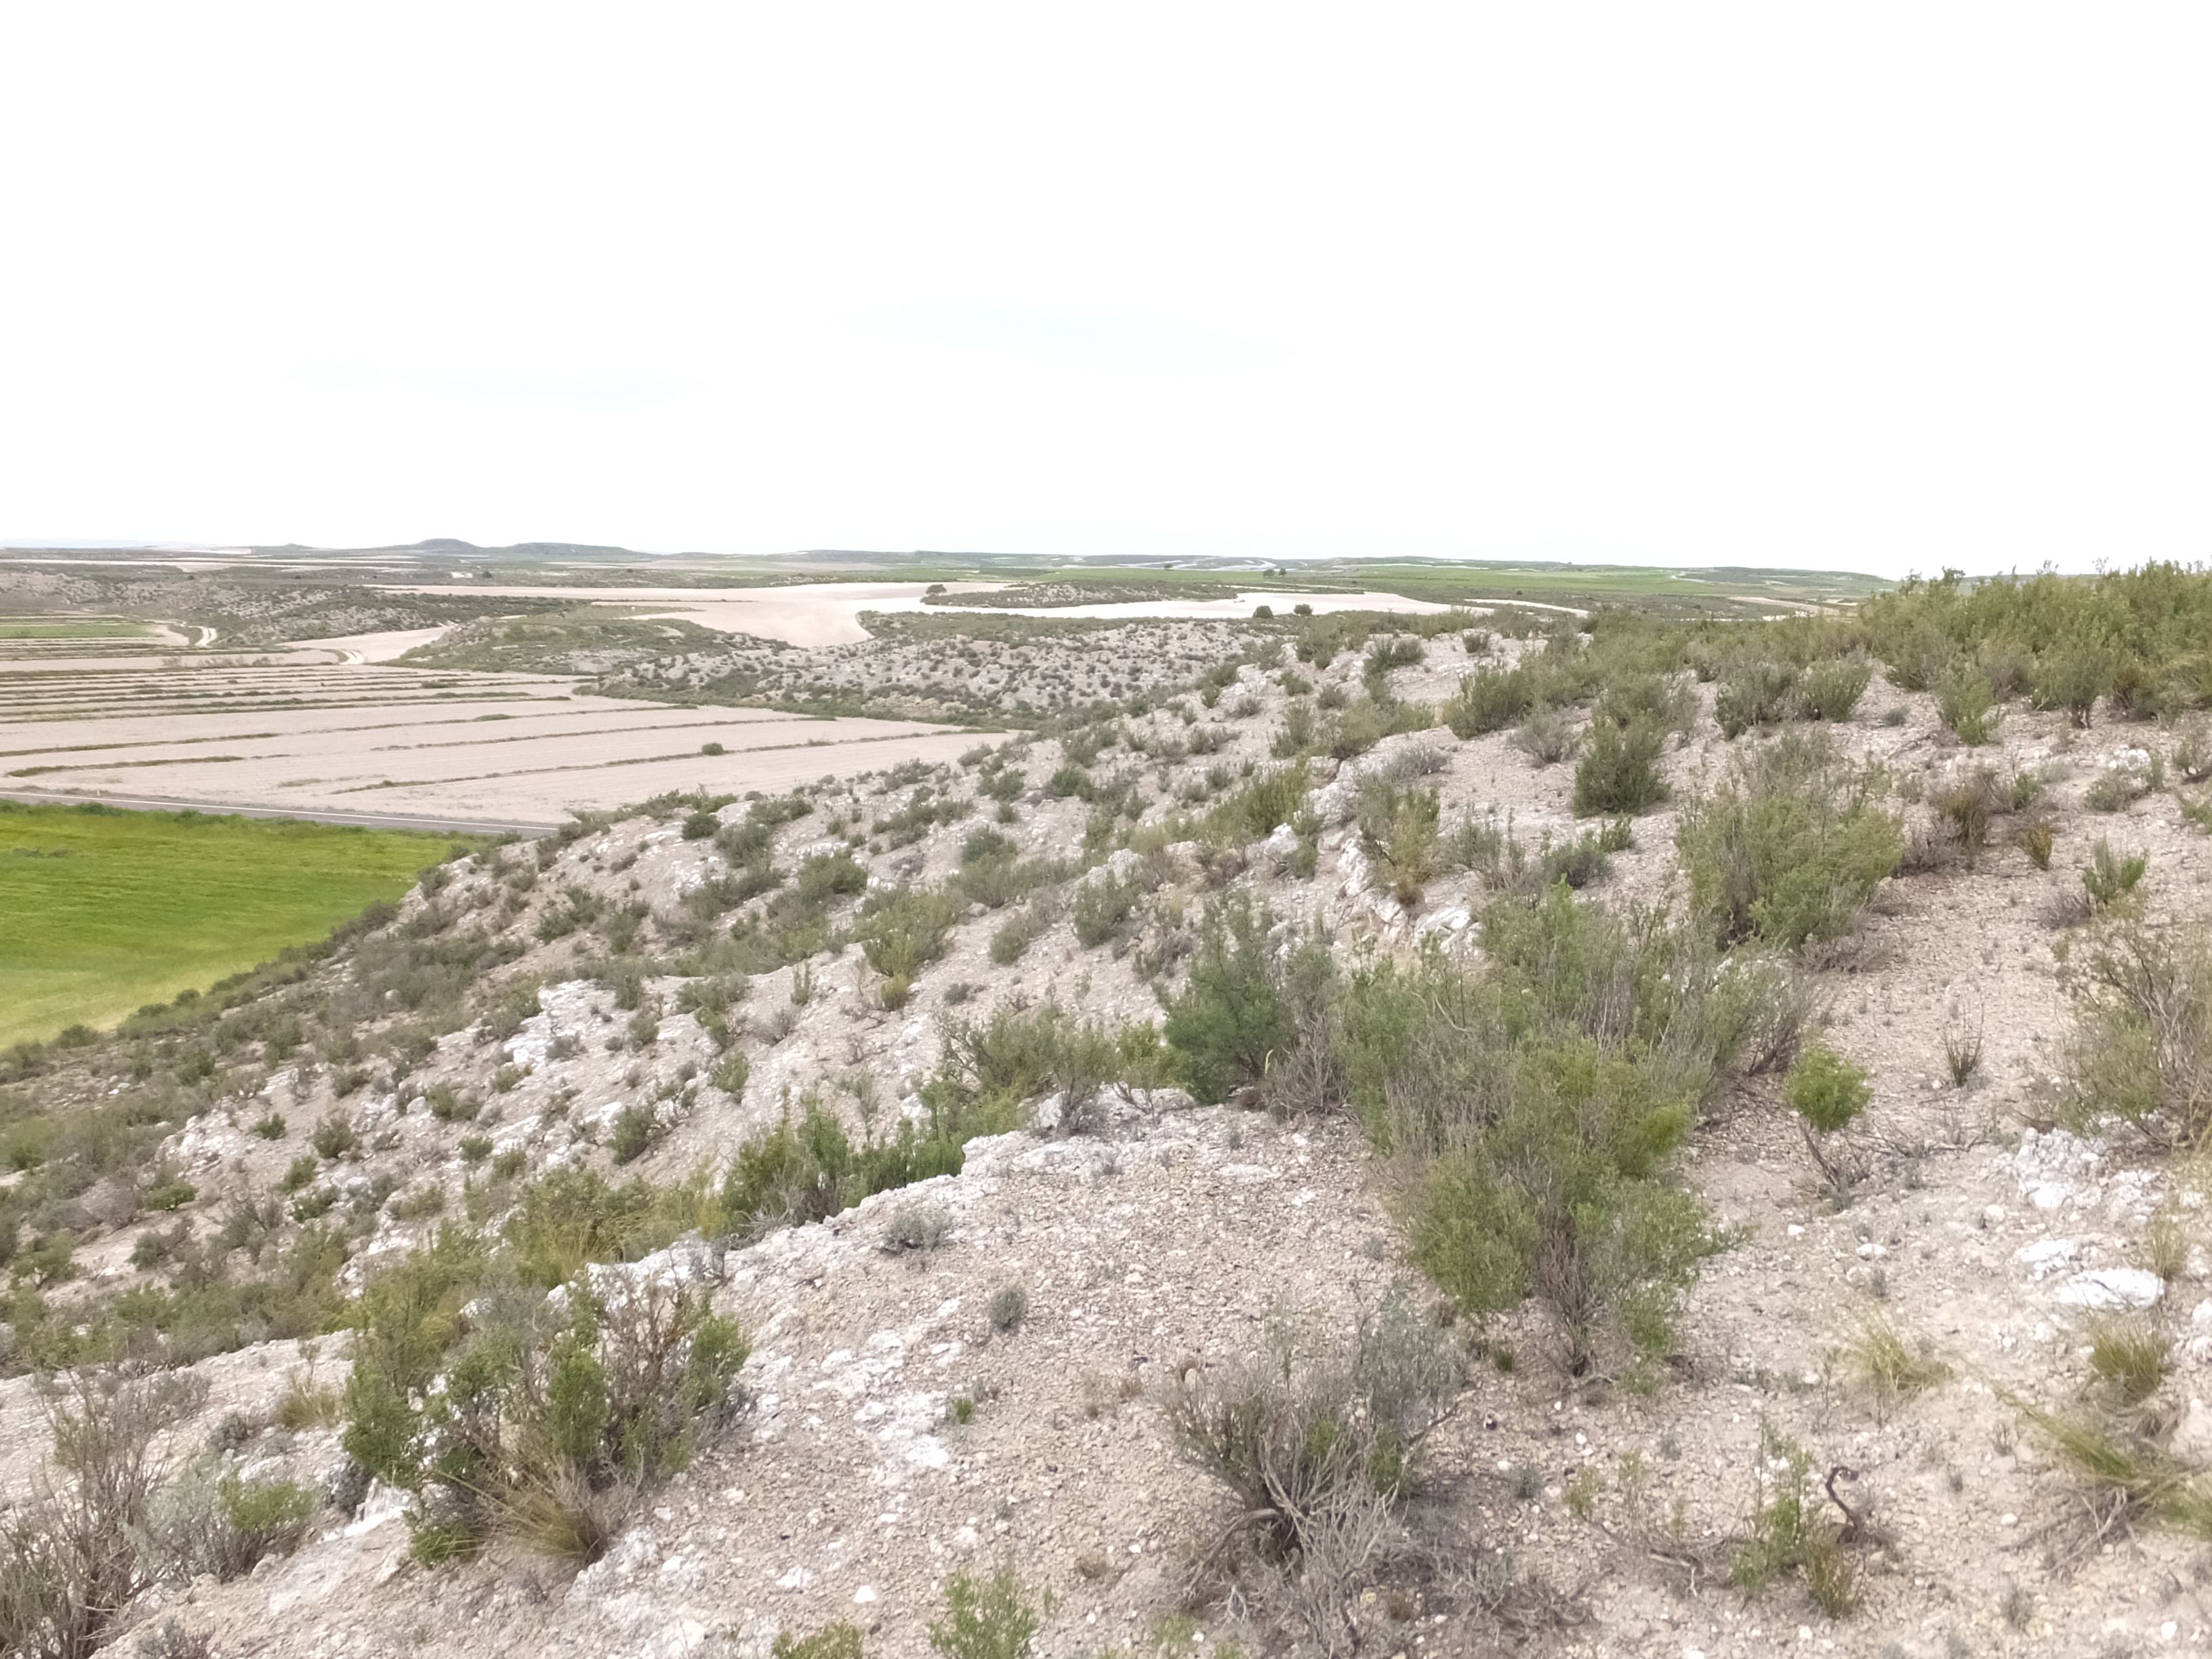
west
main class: Shrubland
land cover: Shrubland without tree cover
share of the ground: 25 - 50 %
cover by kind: shrubs 40 %, consolidated bare surface 35 %, herbaceous plants 25 %
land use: Semi-natural and natural areas not in use
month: May
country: ES
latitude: 41.4852
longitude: -0.3525
